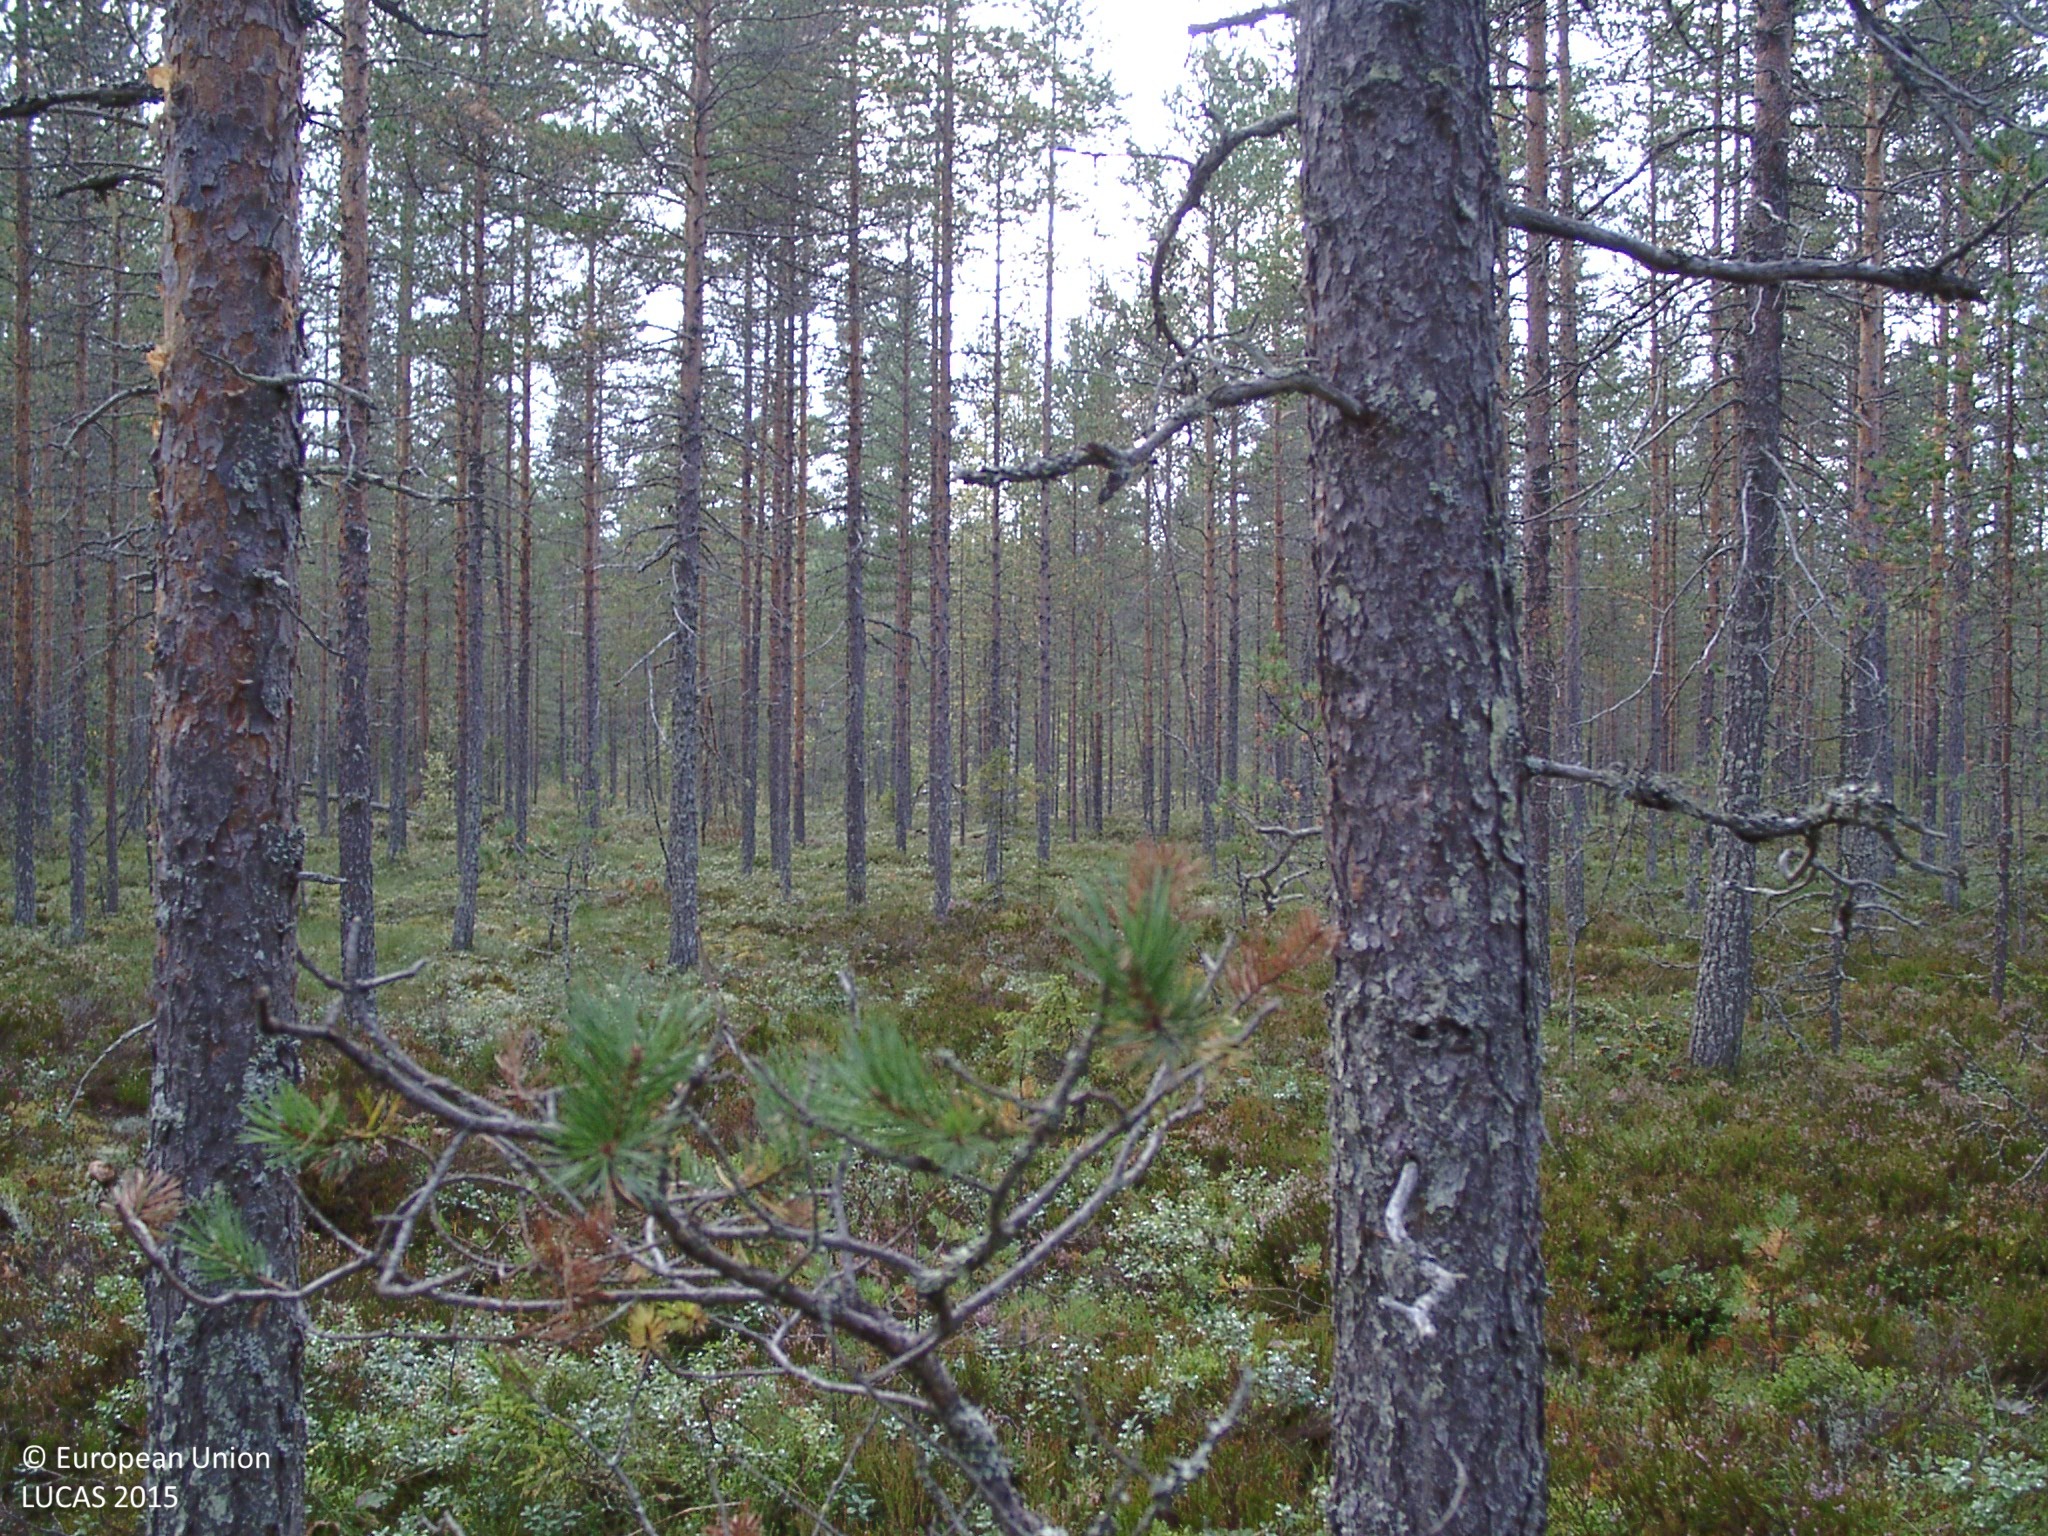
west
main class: Woodland
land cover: Pine dominated coniferous woodland
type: mire and swamp forests
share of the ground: 25 - 50 %
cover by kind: coniferous forest trees 40 %, shrubs 40 %, lichens and mosses 15 %, herbaceous plants 5 %
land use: Forestry
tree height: > 5 m
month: August
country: FI
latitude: 62.3952
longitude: 24.9373
